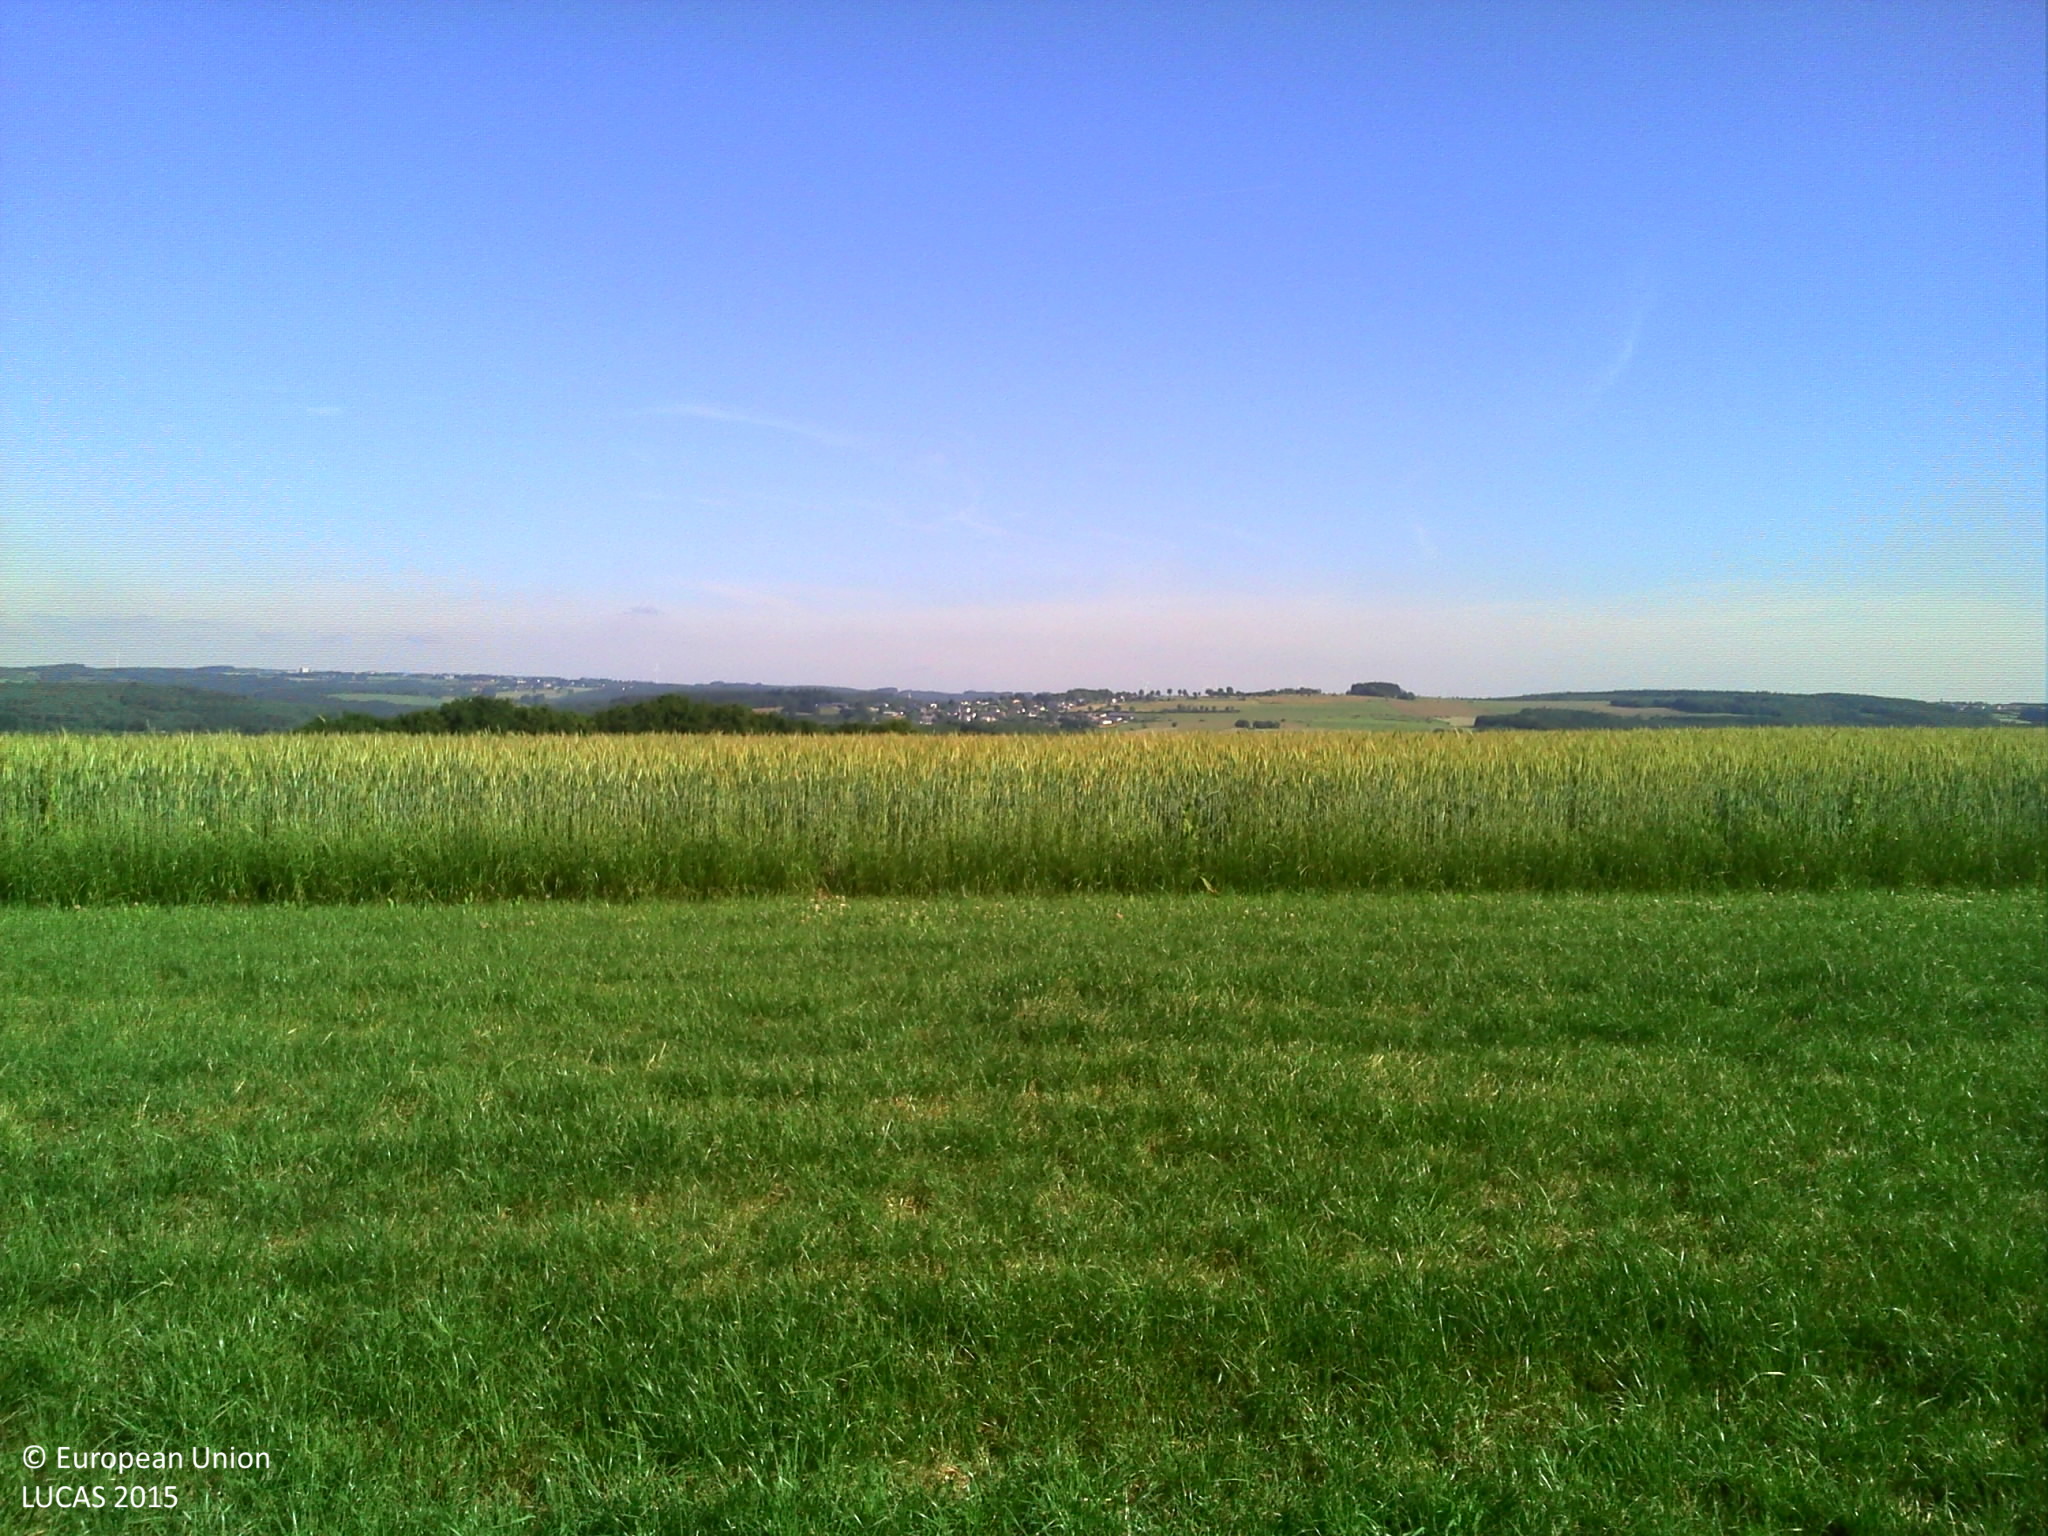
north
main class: Cropland
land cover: Temporary grasslands
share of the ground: > 75 %
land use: Agriculture (excluding fallow land and kitchen gardens)
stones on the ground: 10 - 25 %
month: June
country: LU
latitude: 50.0078
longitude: 6.0504
